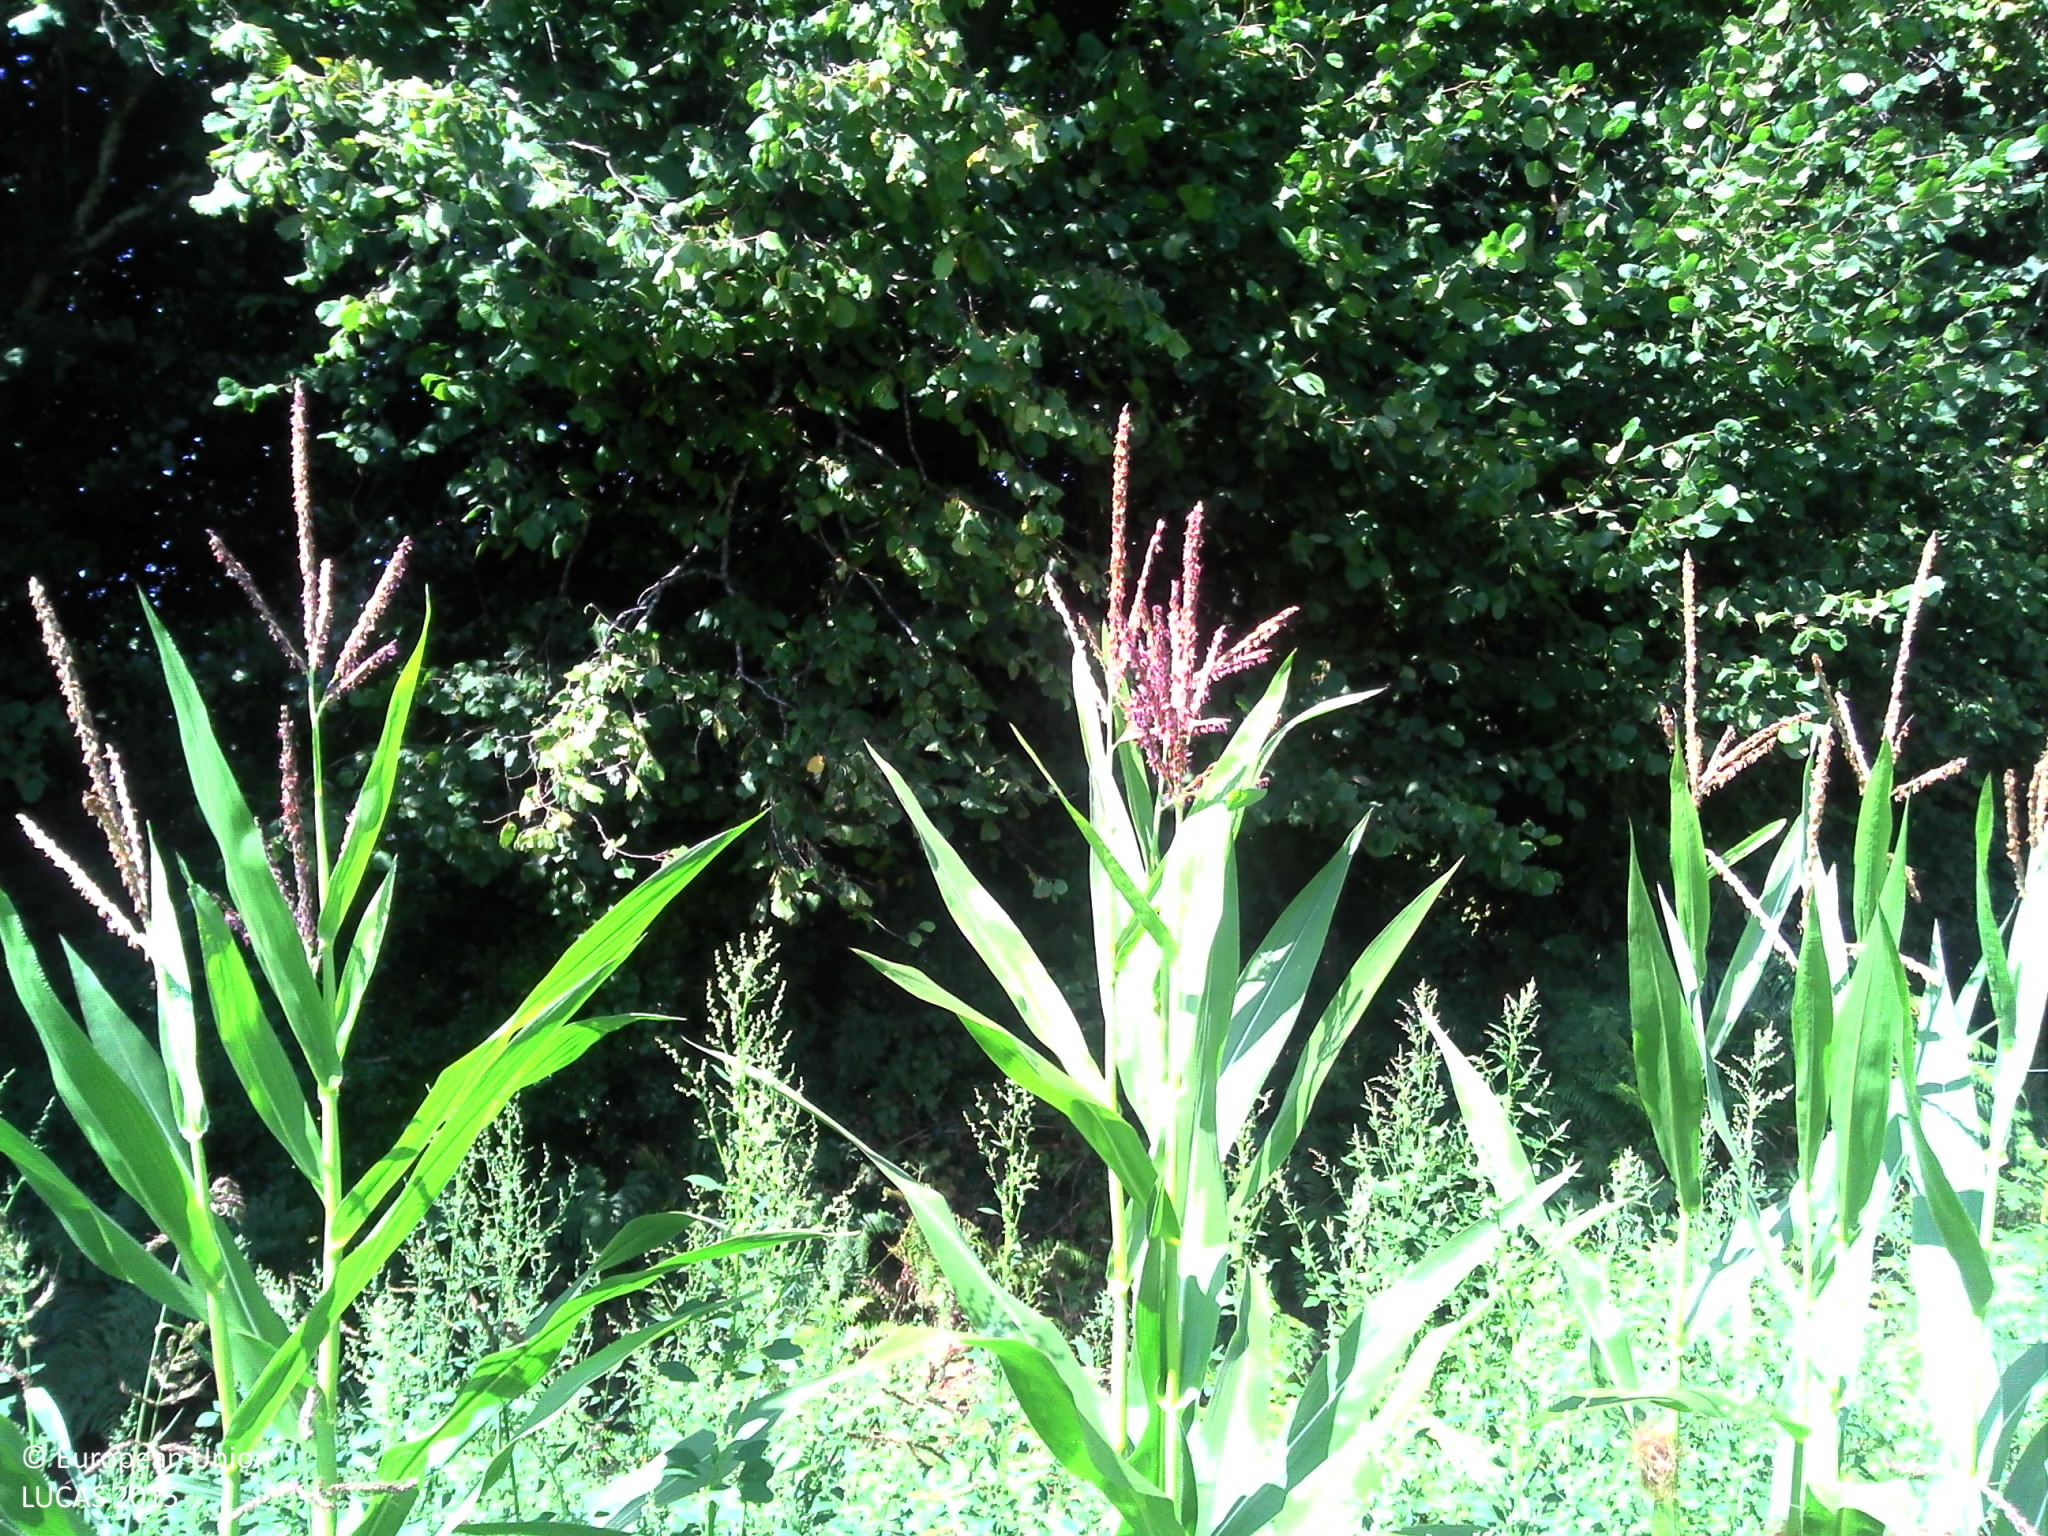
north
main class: Cropland
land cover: Maize
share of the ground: 50 - 75 %
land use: Agriculture (excluding fallow land and kitchen gardens)
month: August
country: FR
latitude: 45.8661
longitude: 1.7106
